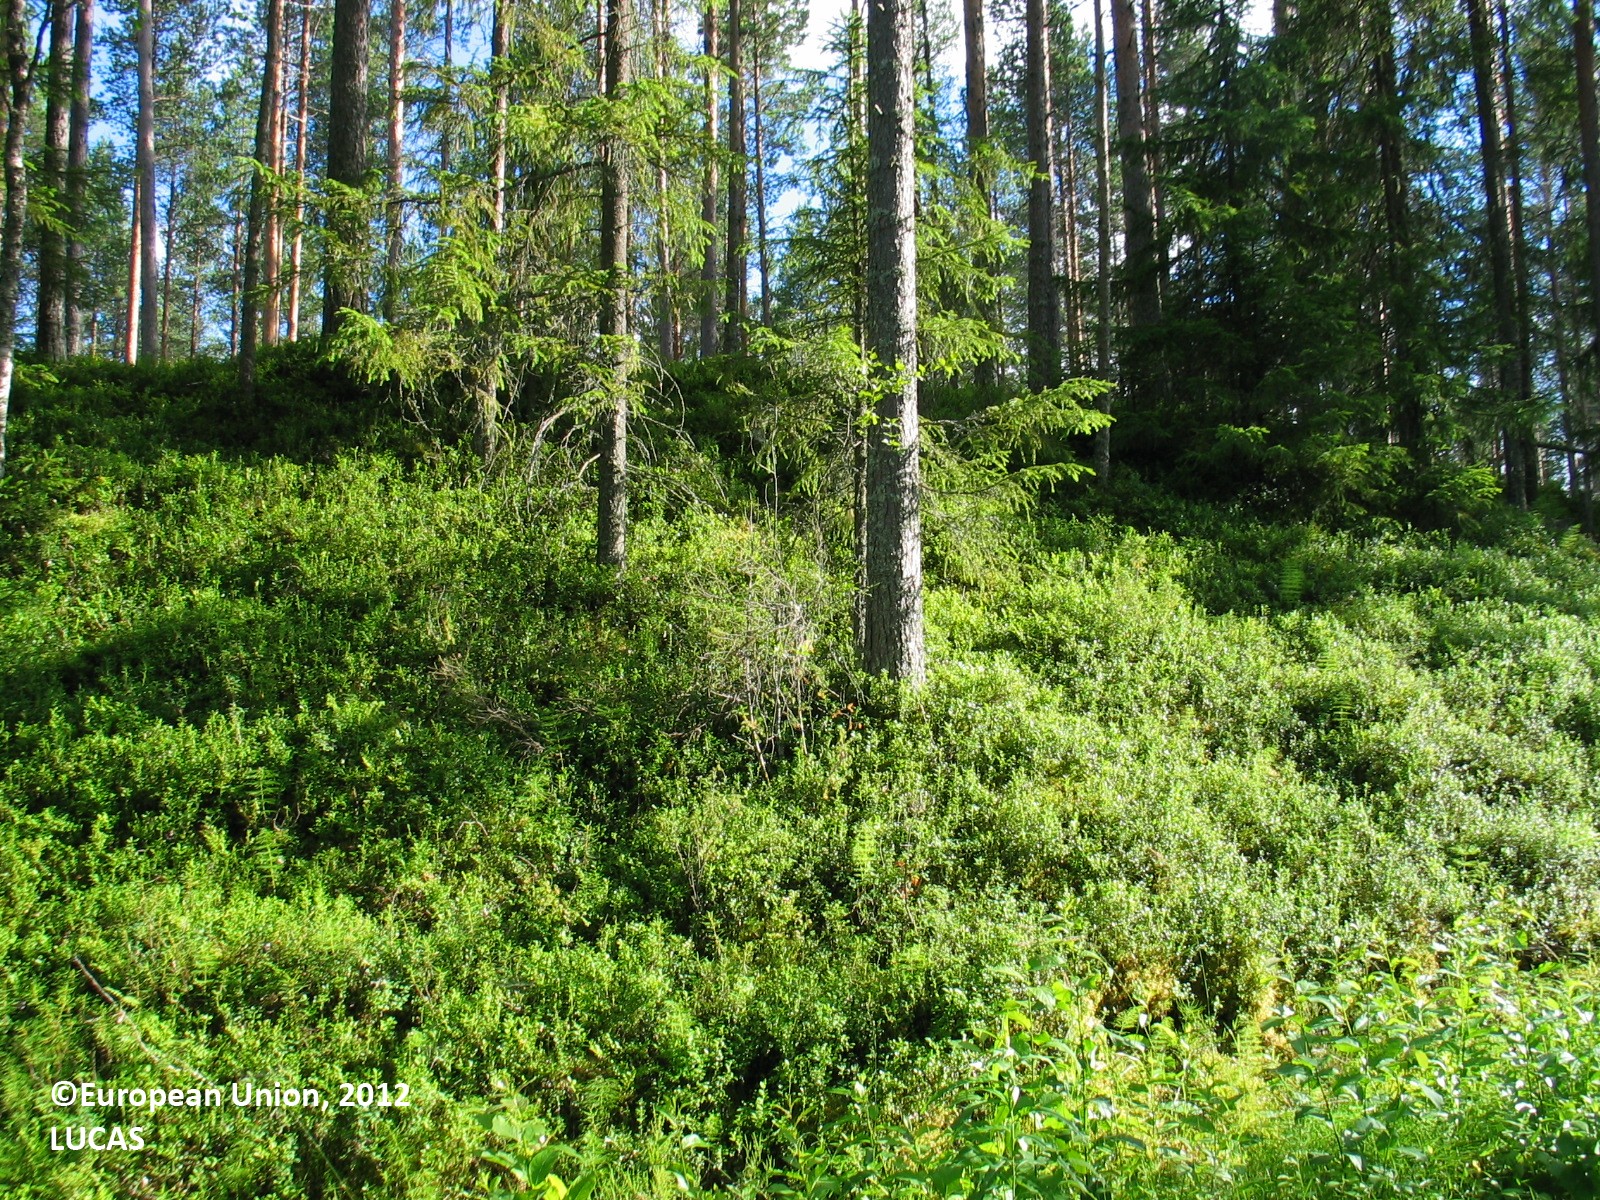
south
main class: Grassland
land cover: Grassland without tree/shrub cover
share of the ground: > 75 %
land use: Amenities, museums, leisure
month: July
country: FI
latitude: 64.6691
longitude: 26.5581
